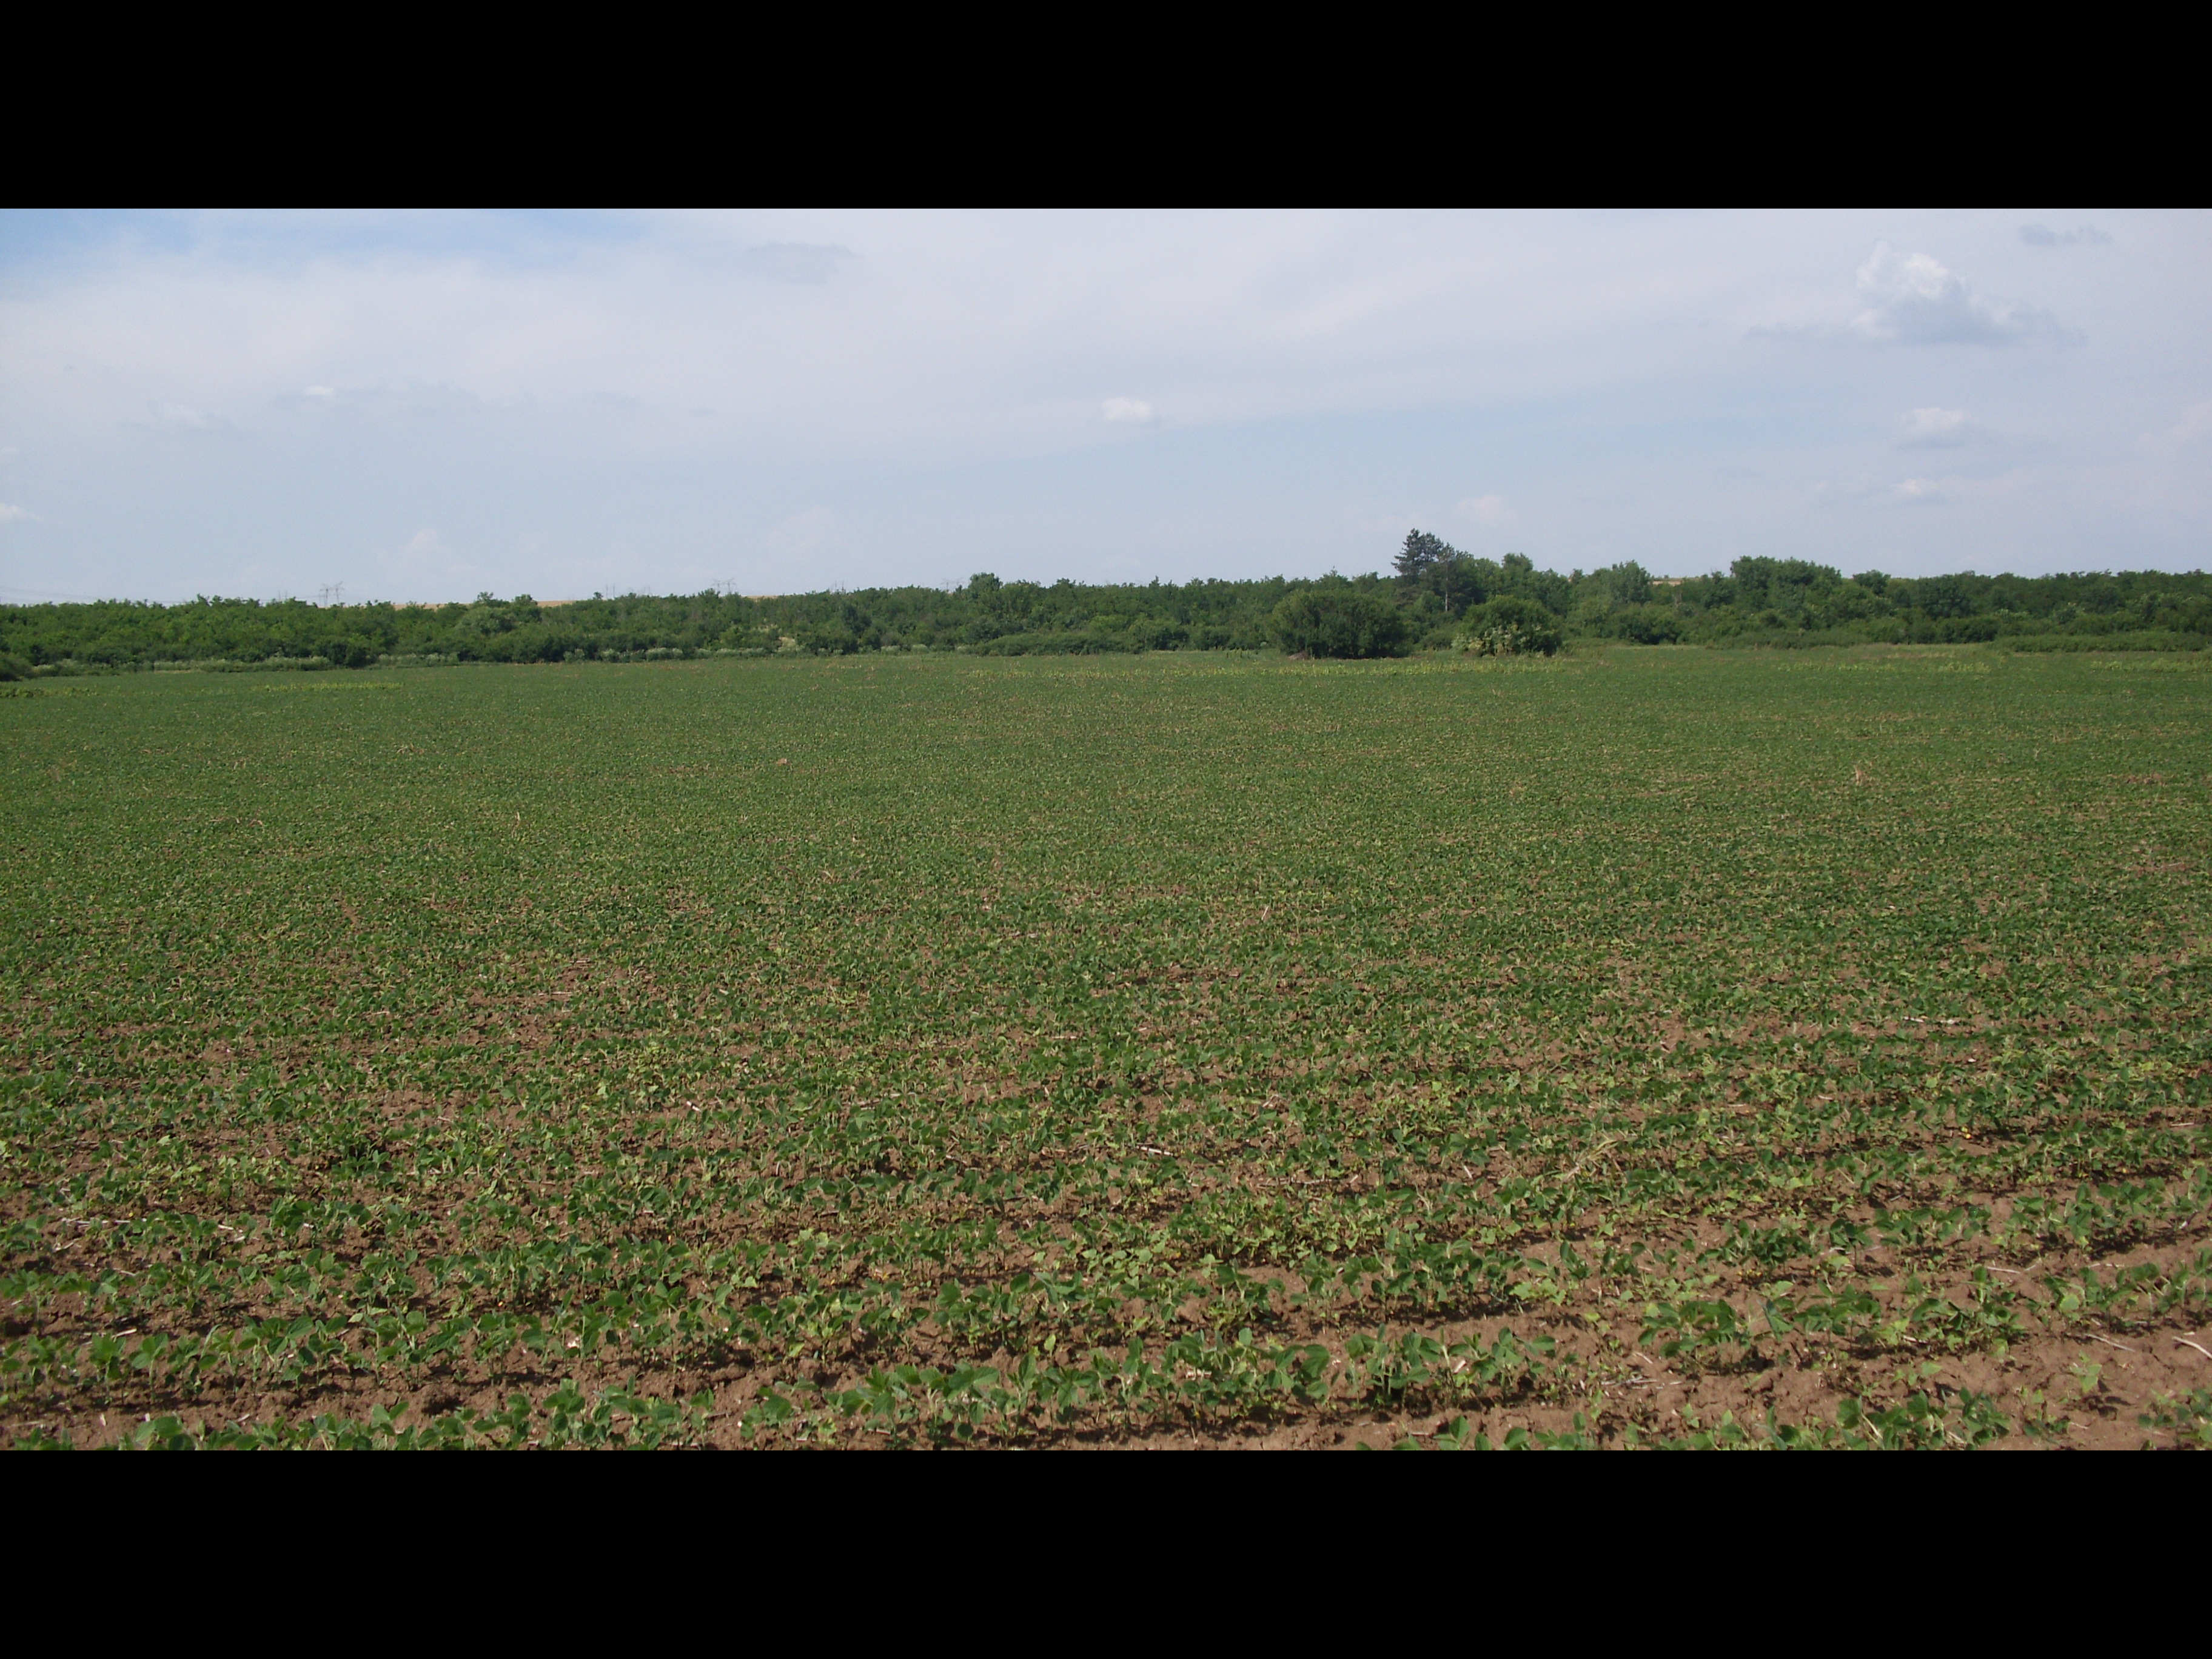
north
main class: Cropland
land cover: Soya
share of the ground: 50 - 75 %
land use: Agriculture (excluding fallow land and kitchen gardens)
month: June
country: BG
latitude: 43.5228
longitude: 23.4681
